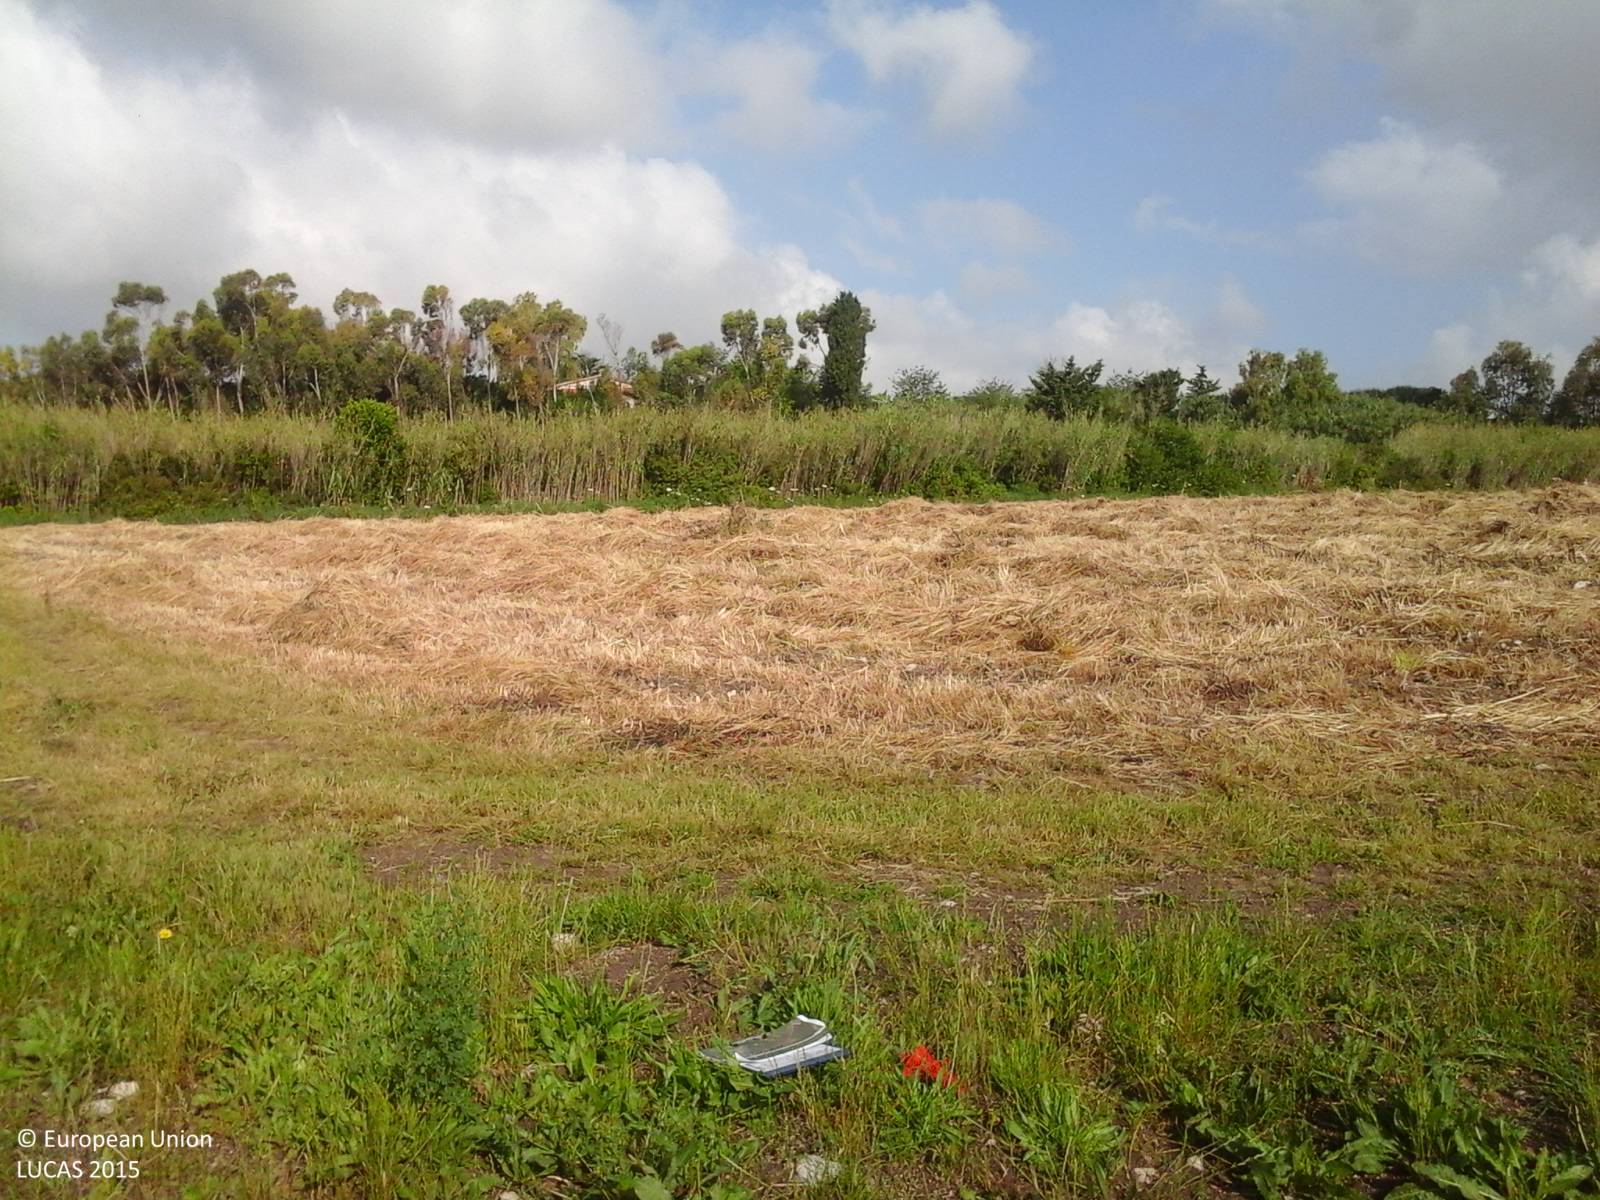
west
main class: Cropland
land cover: Lucerne
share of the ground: 50 - 75 %
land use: Agriculture (excluding fallow land and kitchen gardens)
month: May
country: IT
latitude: 40.6881
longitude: 8.3631
